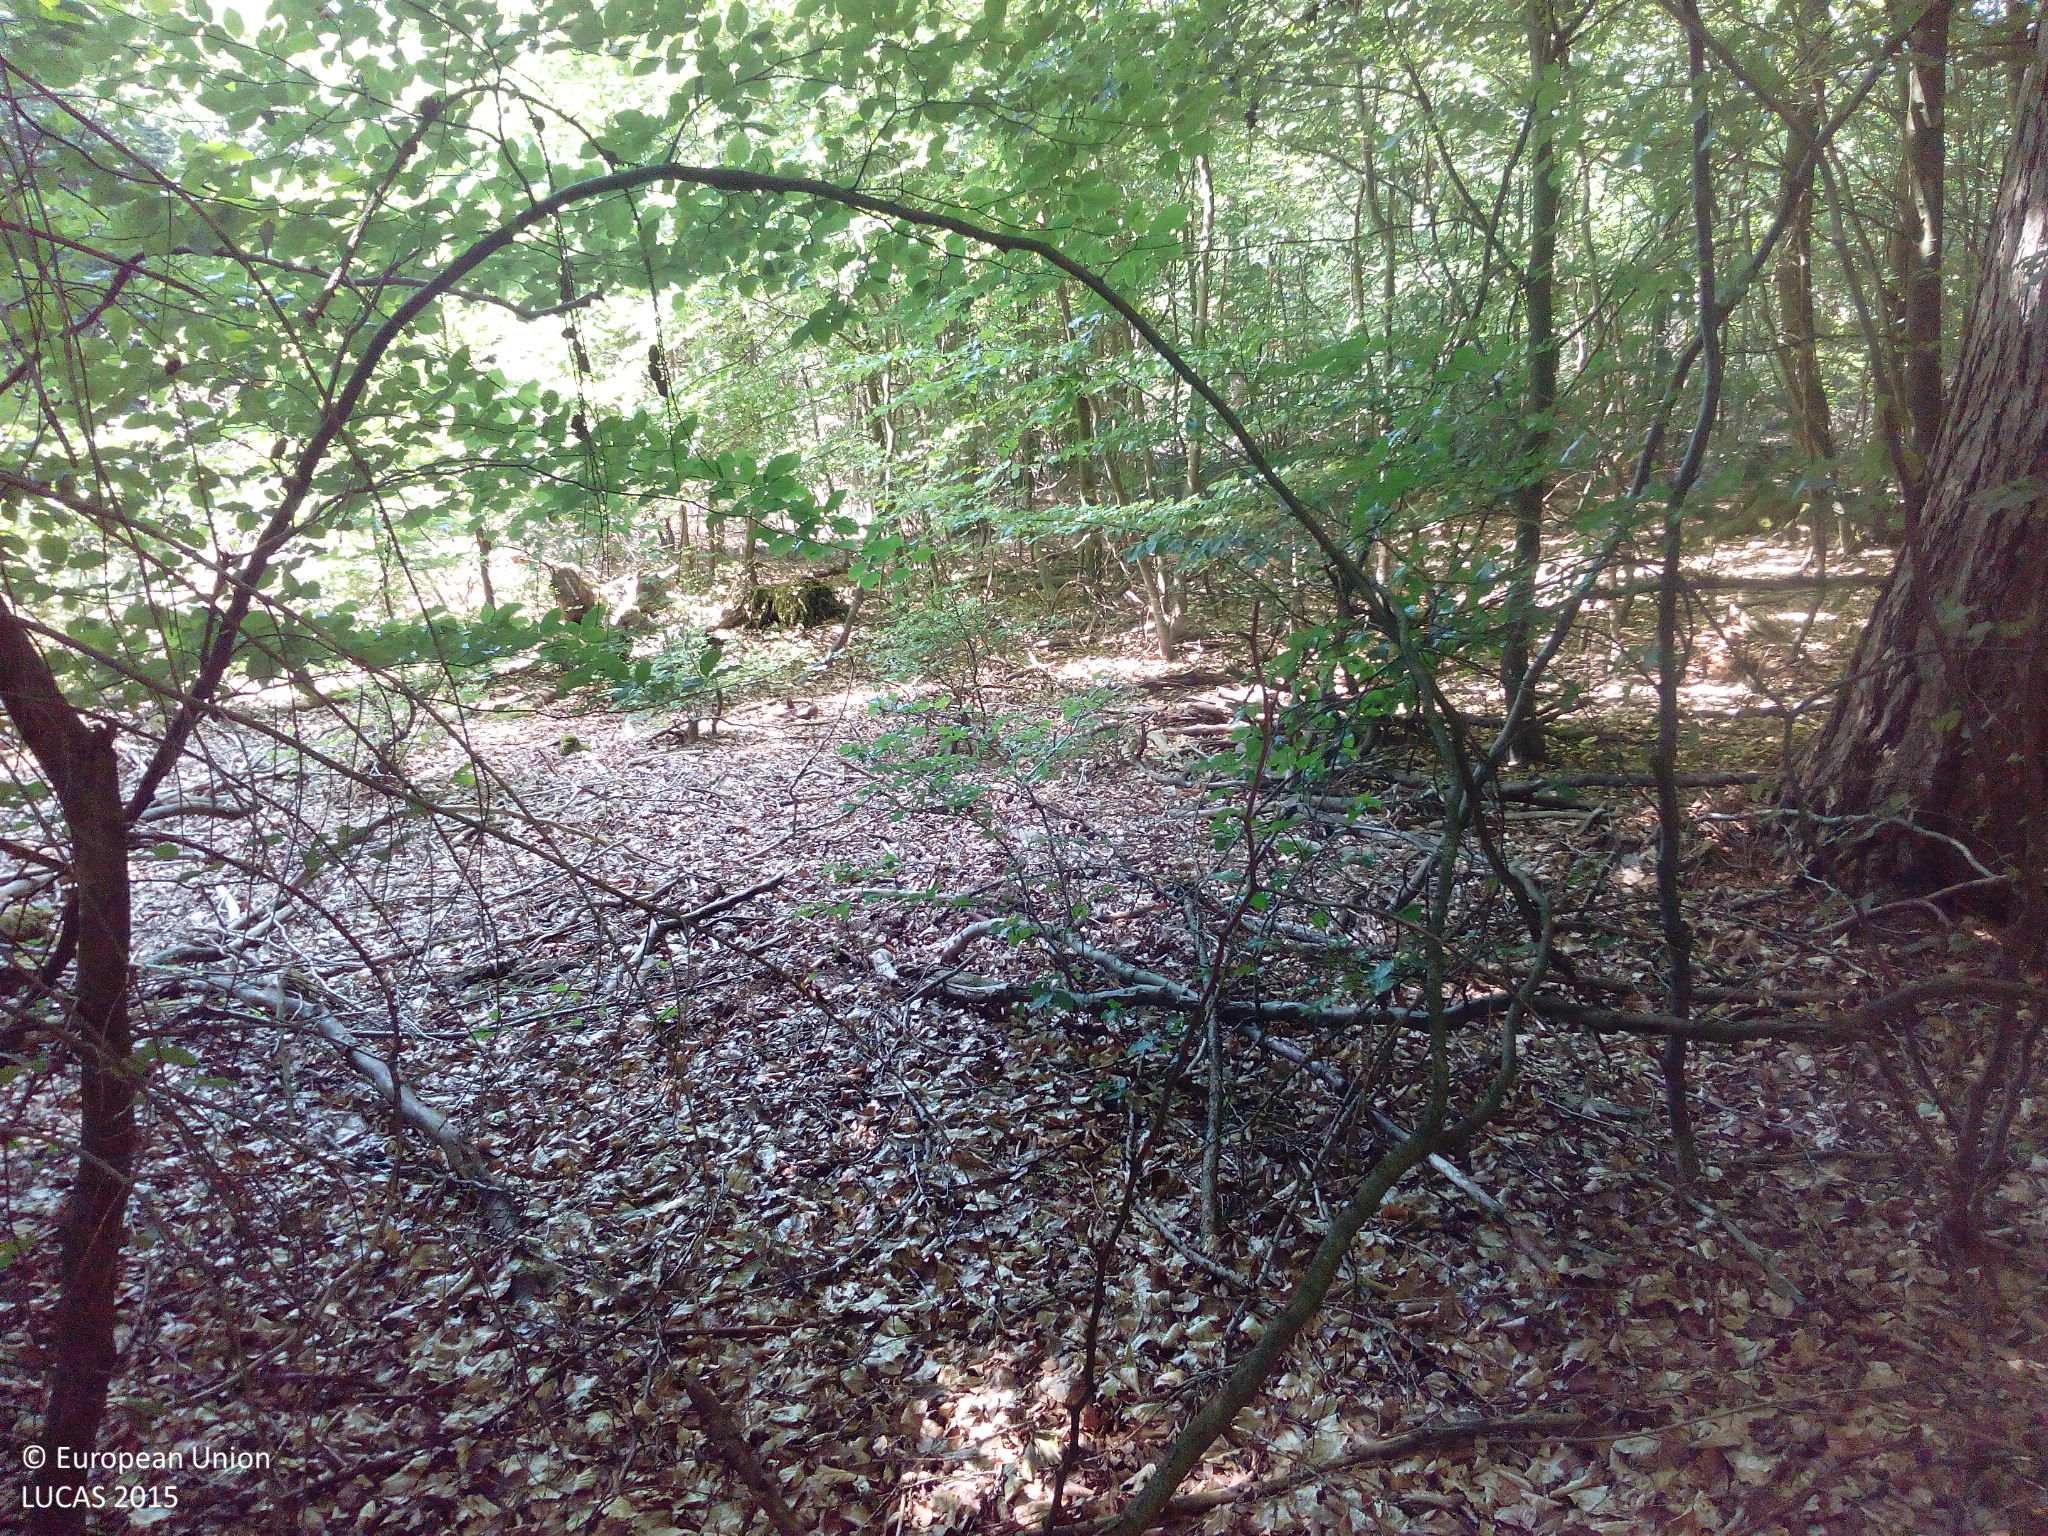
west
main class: Woodland
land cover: Broadleaved woodland
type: mesophytic deciduous forest
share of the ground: > 75 %
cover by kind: broadleaved forest trees 95 %, unconsolidated bare surface 5 %
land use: Forestry
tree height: > 5 m
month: June
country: DE
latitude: 50.1147
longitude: 8.1125
